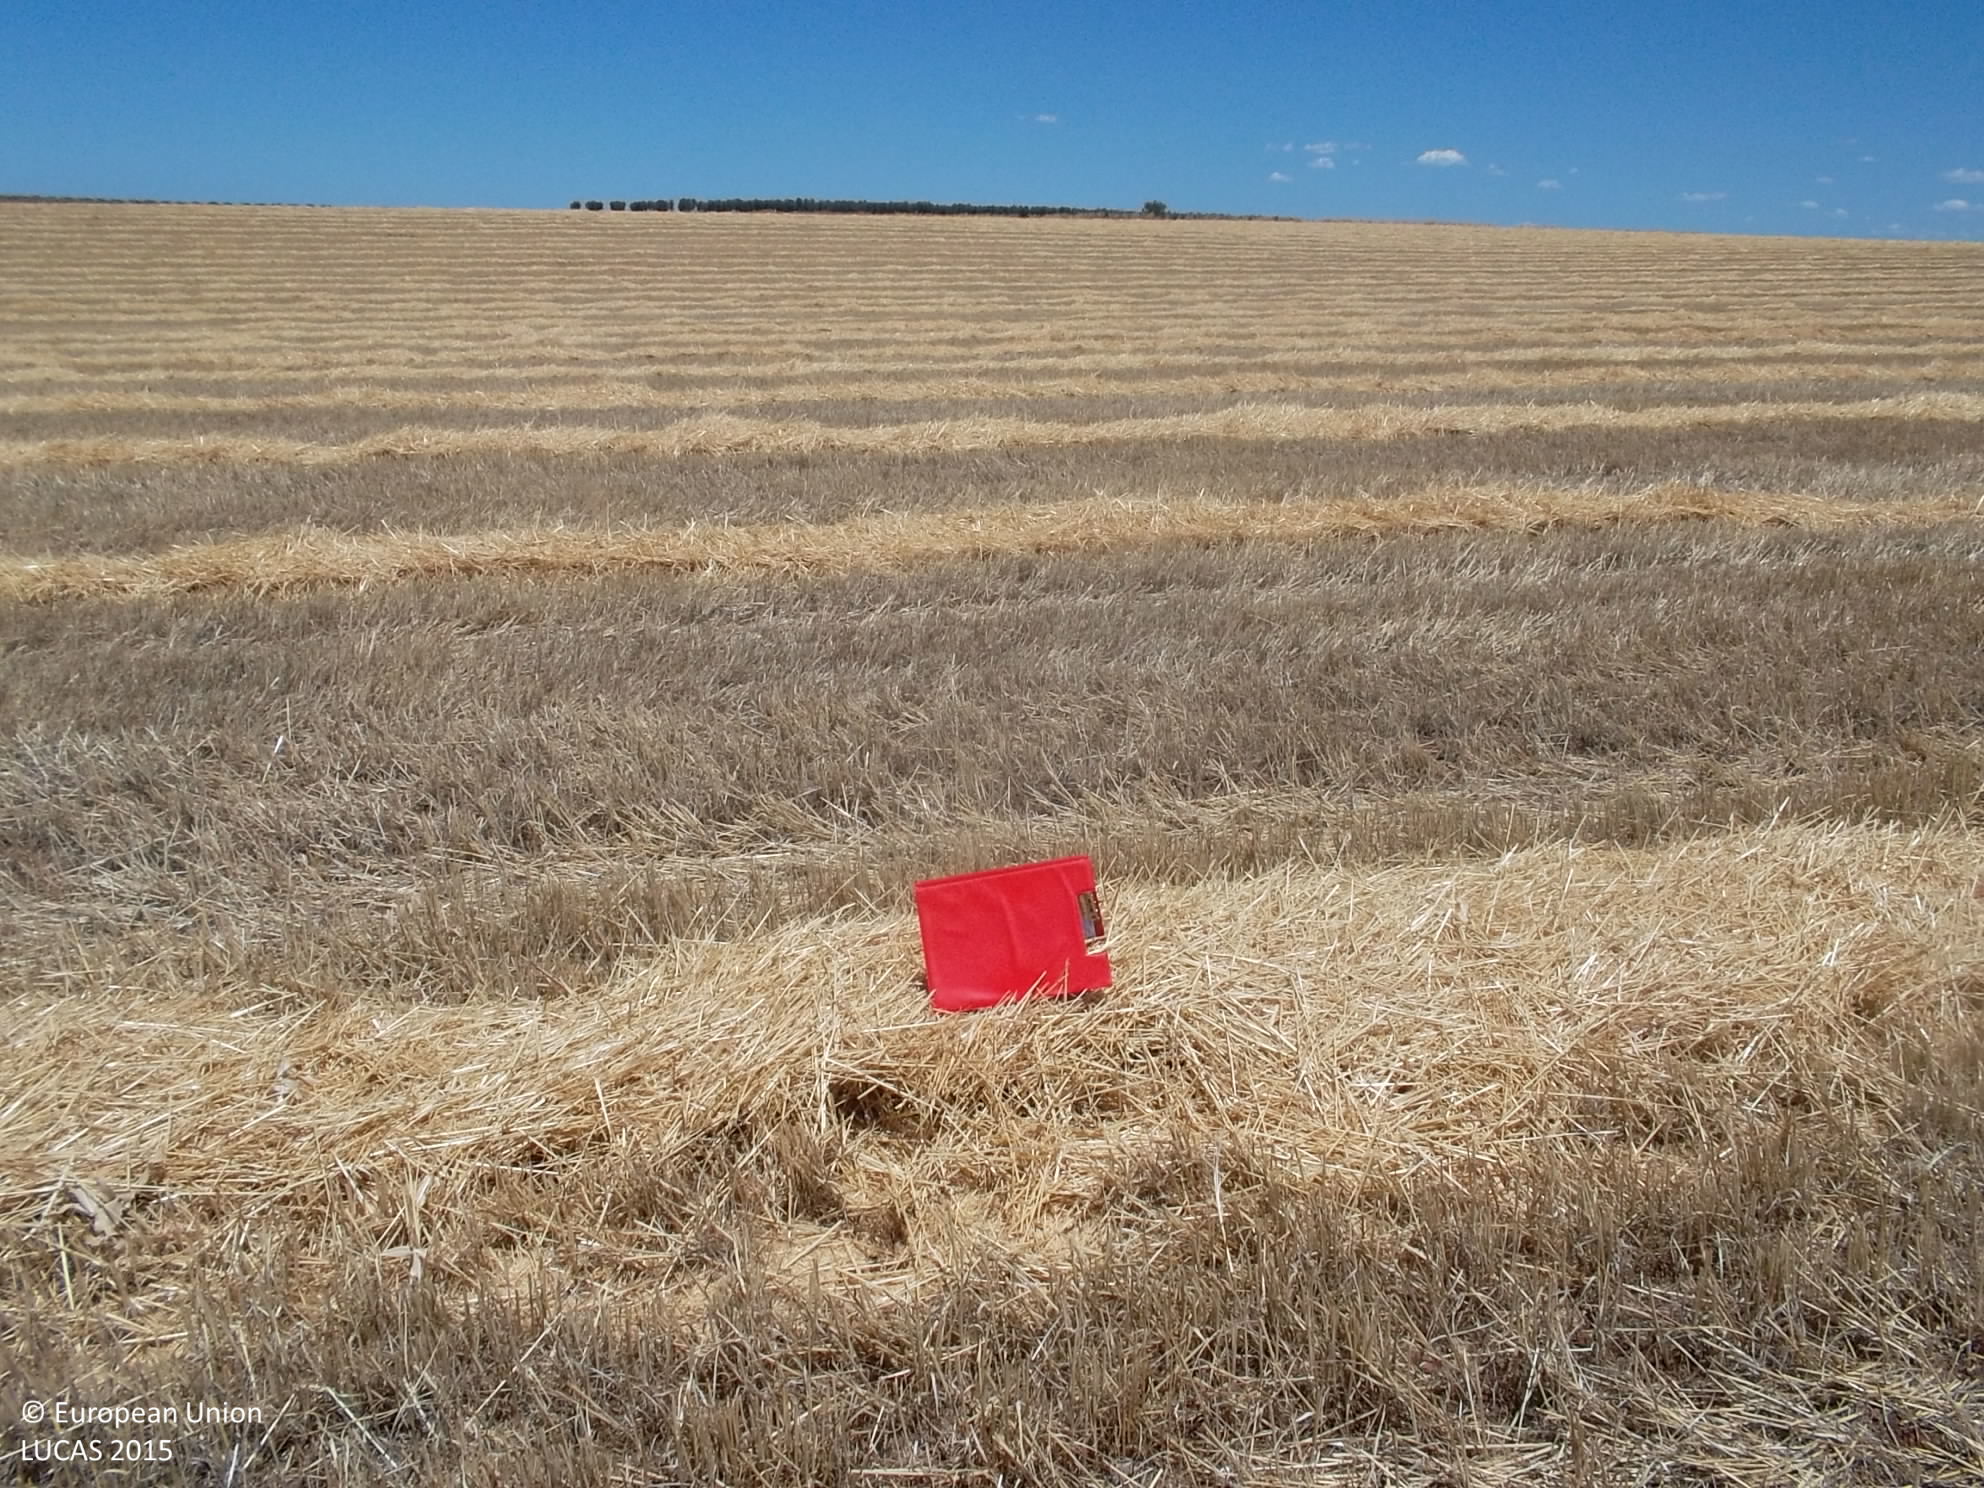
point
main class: Cropland
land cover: Common wheat
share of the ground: < 10 %
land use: Agriculture (excluding fallow land and kitchen gardens)
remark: Harvested field
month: July
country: ES
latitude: 38.3530
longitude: -5.7950
